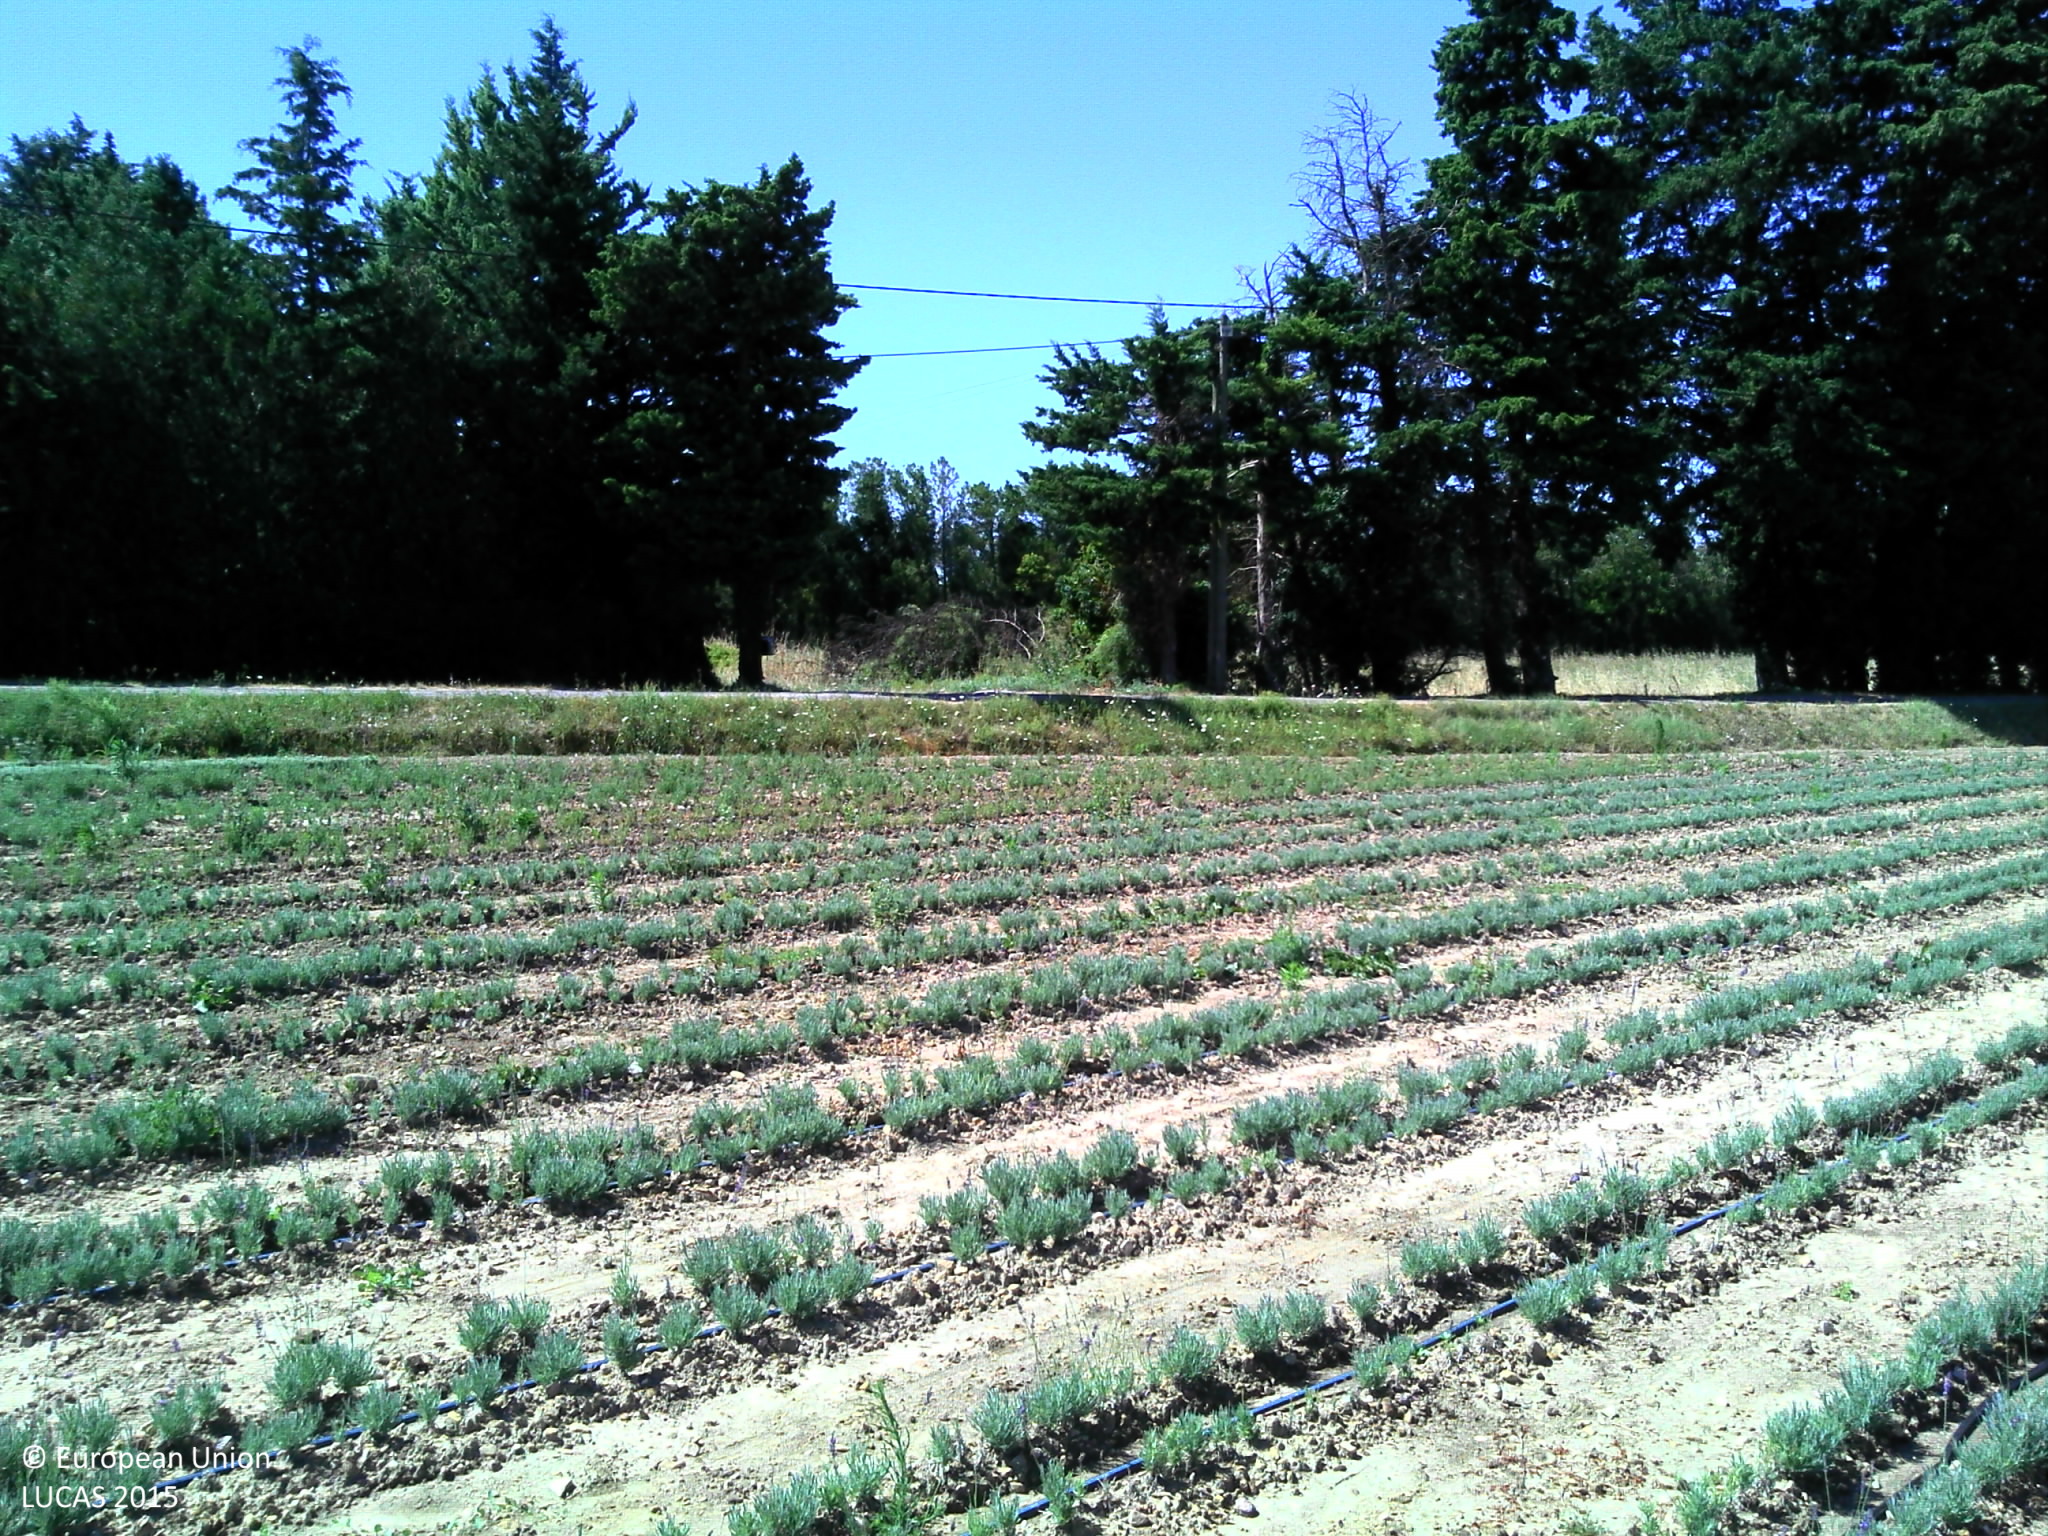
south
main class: Cropland
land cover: Permanent industrial crops
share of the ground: 25 - 50 %
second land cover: Other bare soil
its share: > 75 %
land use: Agriculture (excluding fallow land and kitchen gardens)
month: July
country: FR
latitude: 43.8911
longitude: 5.0917
